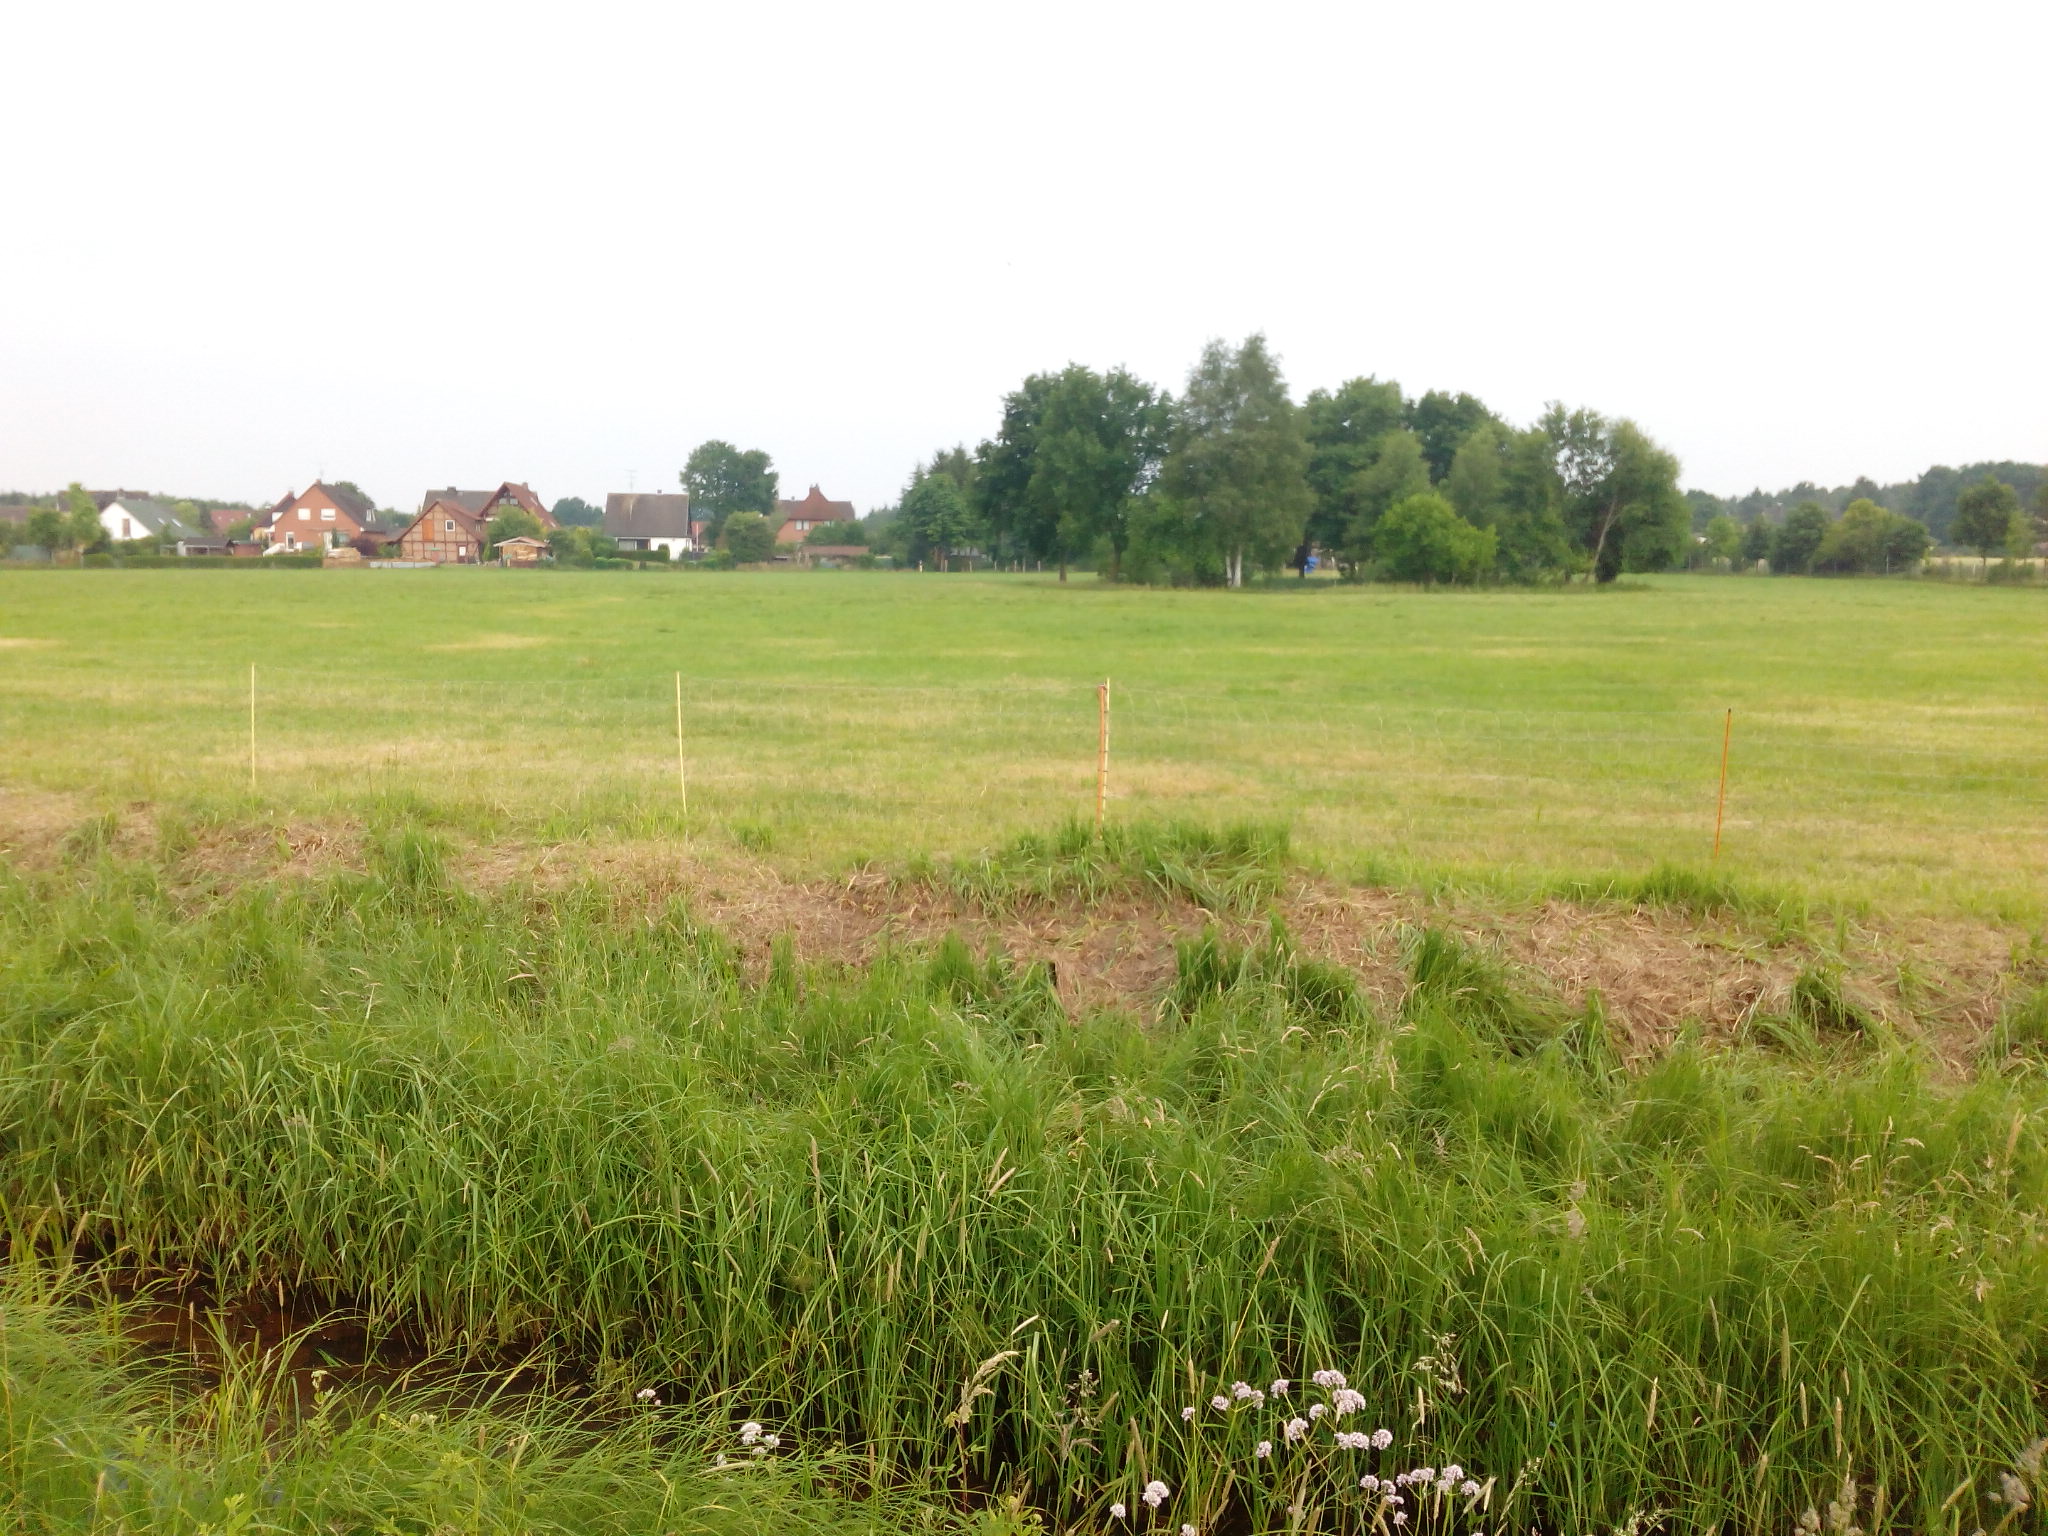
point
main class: Grassland
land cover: Grassland without tree/shrub cover
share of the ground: > 75 %
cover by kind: herbaceous plants 100 %
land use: Agriculture (excluding fallow land and kitchen gardens)
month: June
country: DE
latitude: 52.7722
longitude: 9.6000
